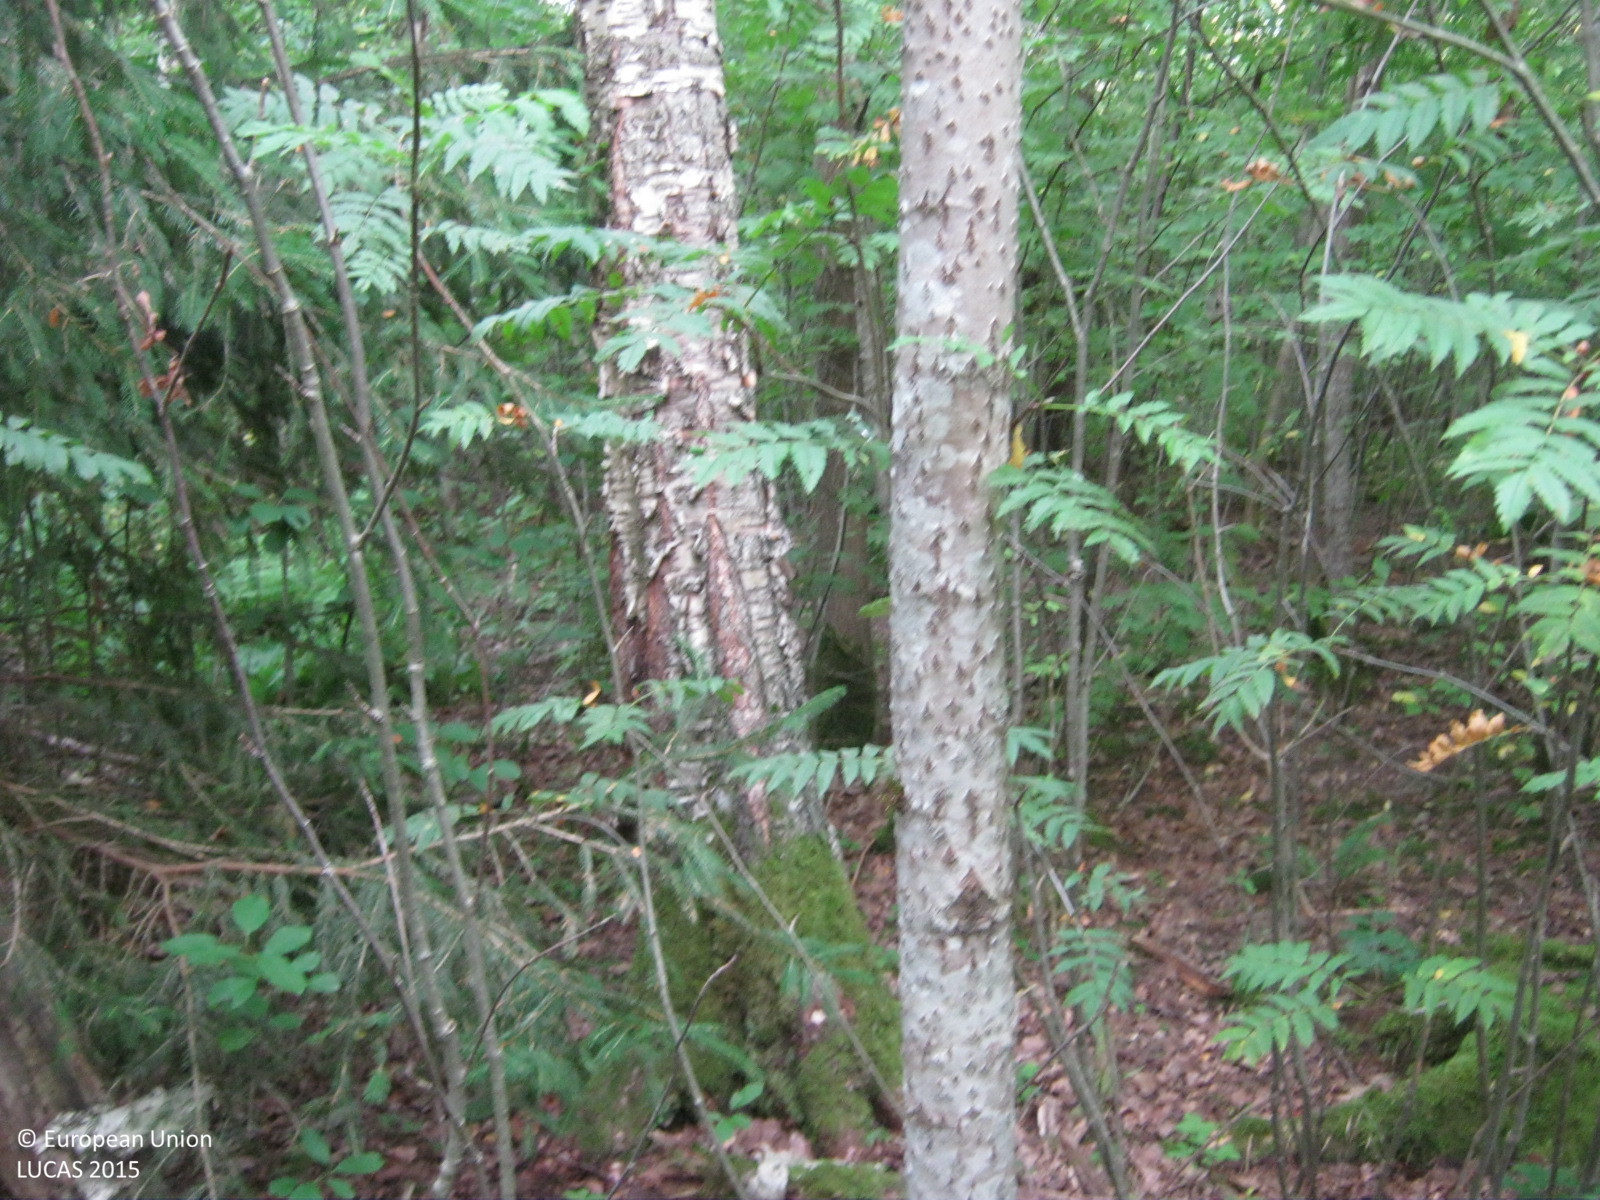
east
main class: Woodland
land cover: Broadleaved woodland
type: non-riverine alder, birch or aspen forest
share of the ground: > 75 %
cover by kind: broadleaved forest trees 80 %, coniferous forest trees 10 %, herbaceous plants 5 %, unconsolidated bare surface 5 %
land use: Forestry
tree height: > 5 m
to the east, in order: Broadleaved woodland
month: August
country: LV
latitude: 57.3916
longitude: 24.6533
